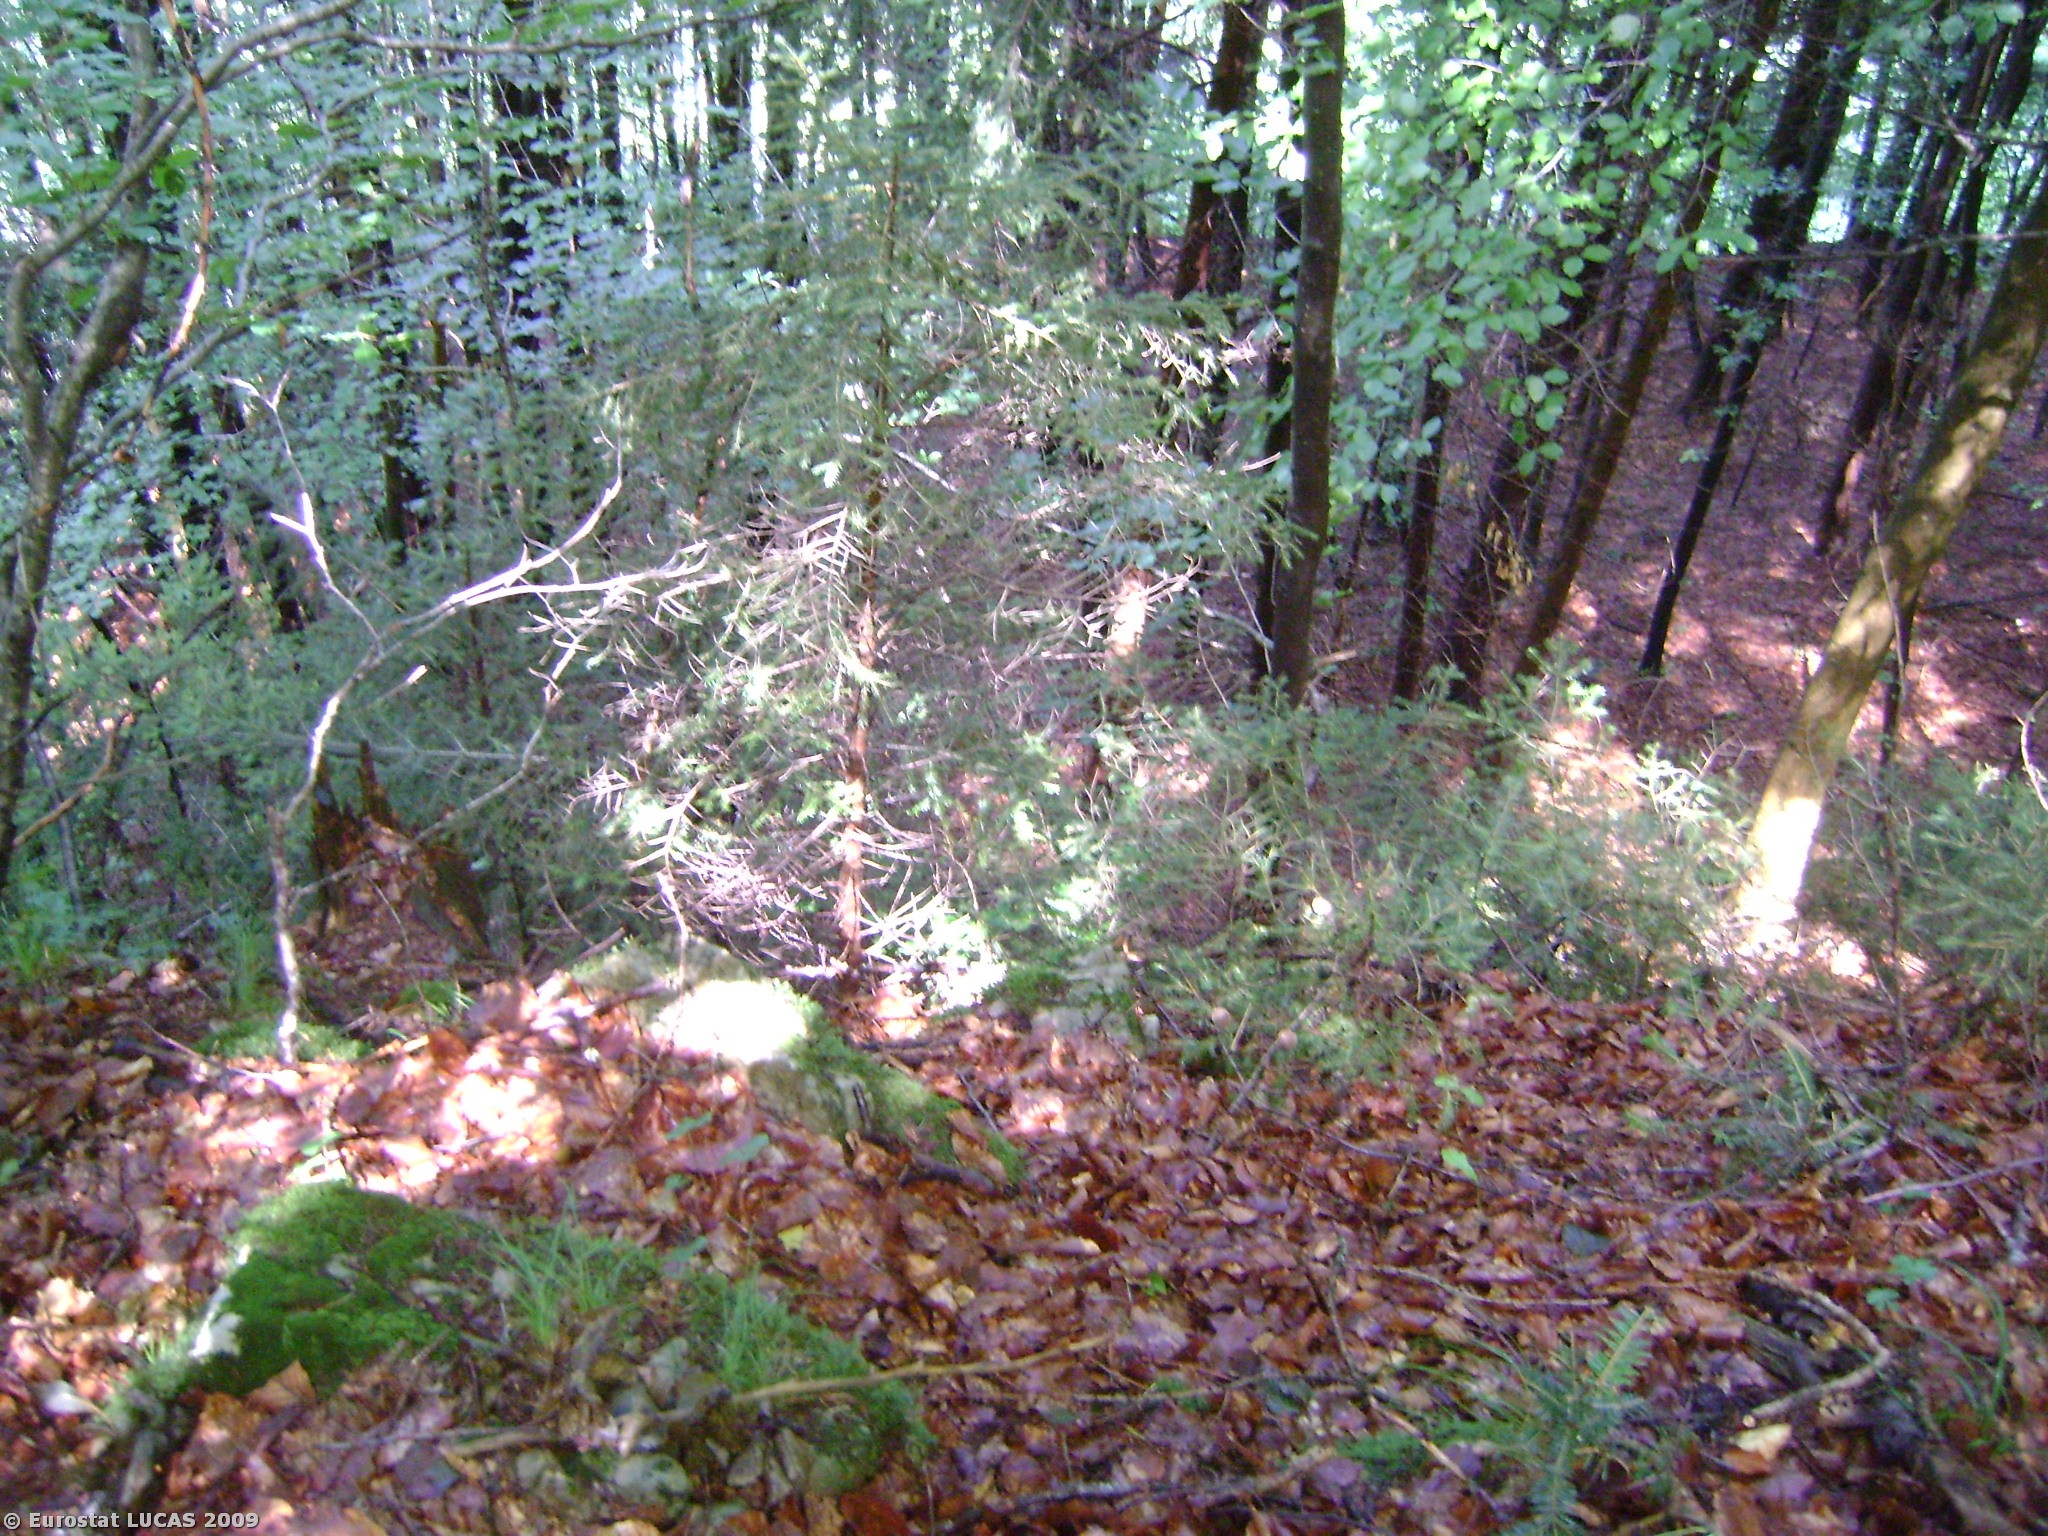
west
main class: Woodland
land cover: Broadleaved woodland
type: beech forest
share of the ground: > 75 %
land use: Forestry
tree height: > 5 m
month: August
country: AT
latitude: 47.3051
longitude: 9.6697
